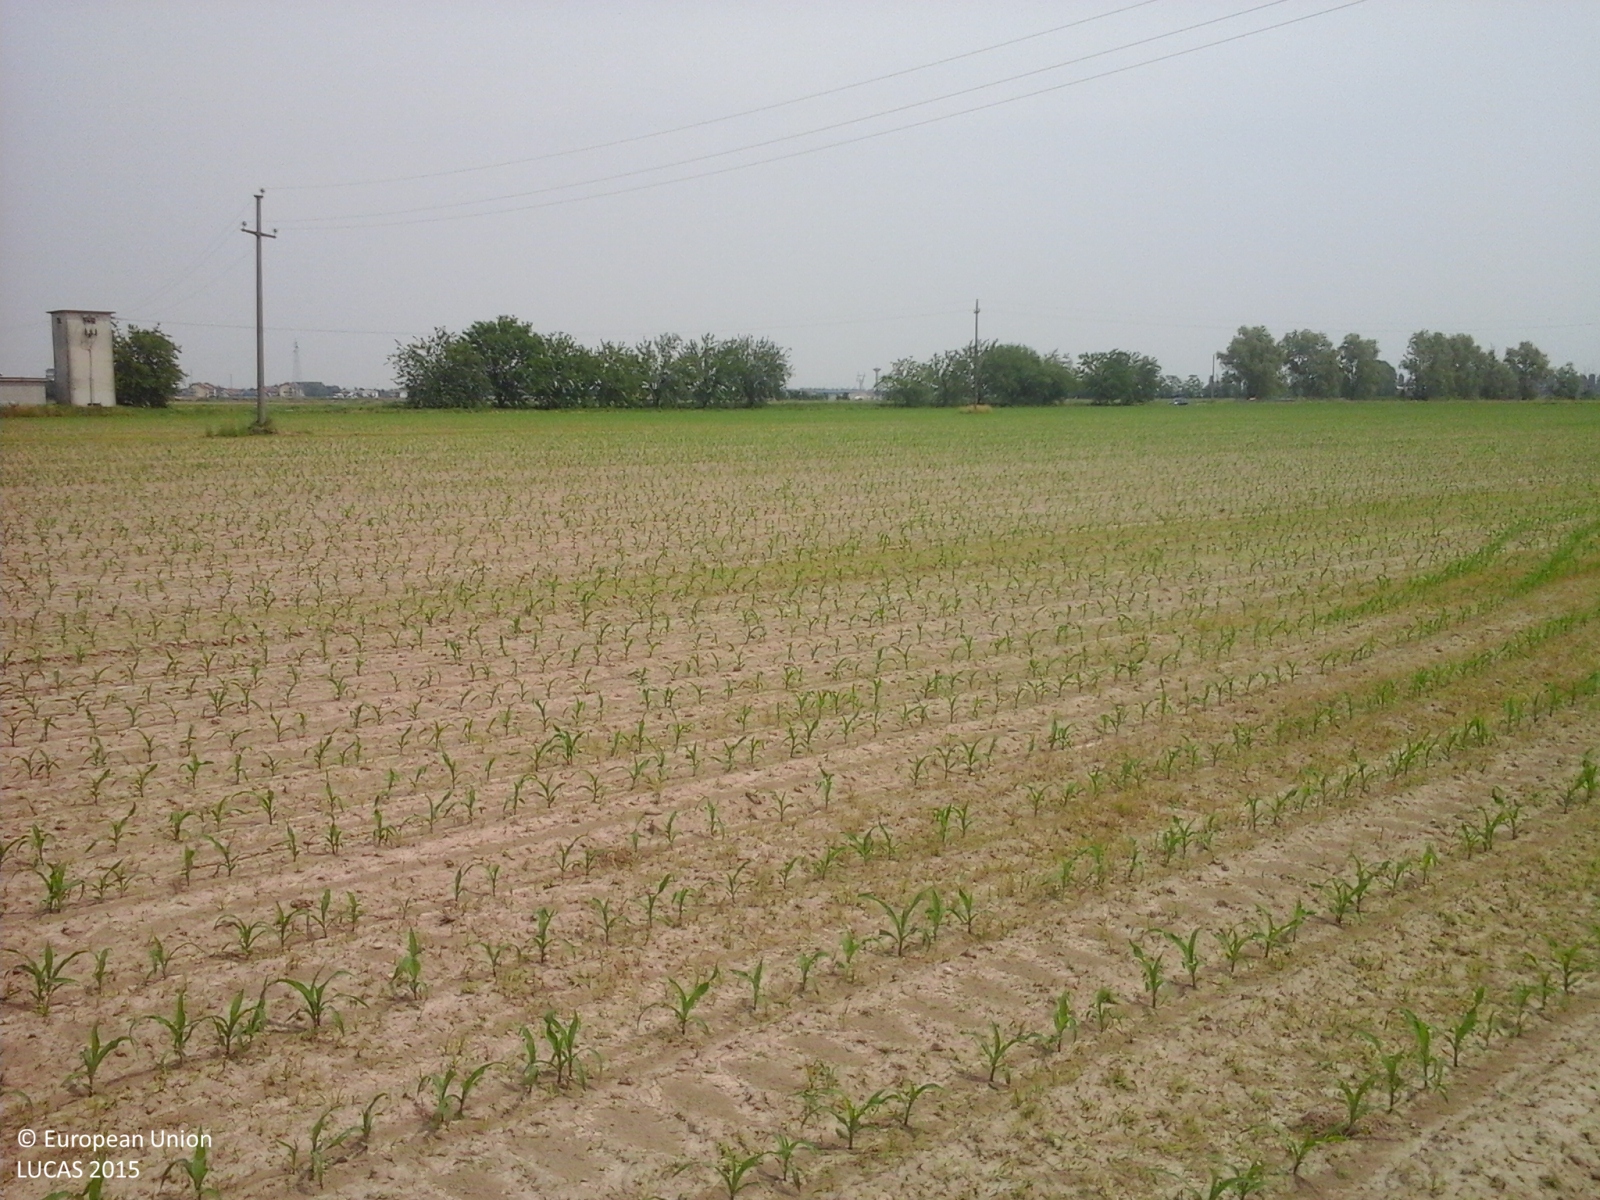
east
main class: Cropland
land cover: Maize
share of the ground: < 10 %
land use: Agriculture (excluding fallow land and kitchen gardens)
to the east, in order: Maize; Electric lines; Maize; Electric lines; Maize; Grass margins; Paved roads, cycling and walking lanes; Grass margins; Ditches and canals; Managed hedges; Maize
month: May
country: IT
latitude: 45.3399
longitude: 9.2994
